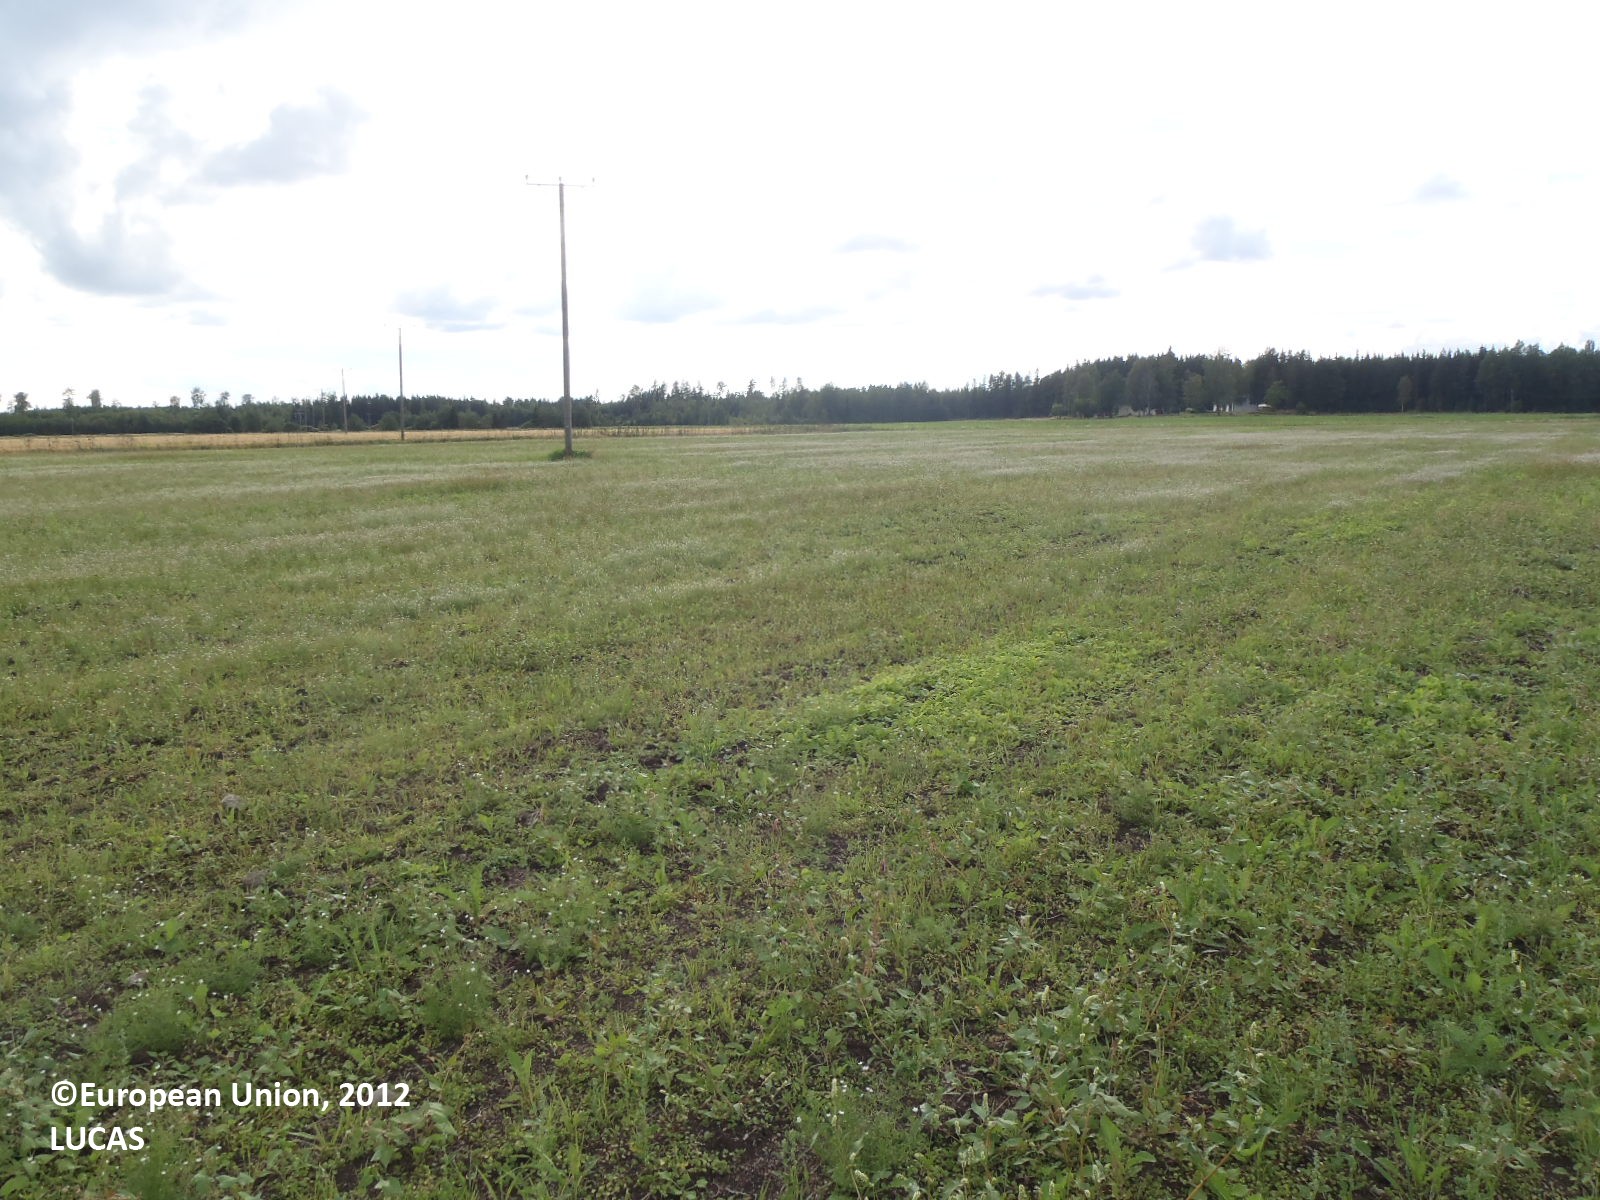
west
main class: Cropland
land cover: Sugar beet
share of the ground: > 75 %
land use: Agriculture (excluding fallow land and kitchen gardens)
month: August
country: FI
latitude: 60.6553
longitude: 22.3787
